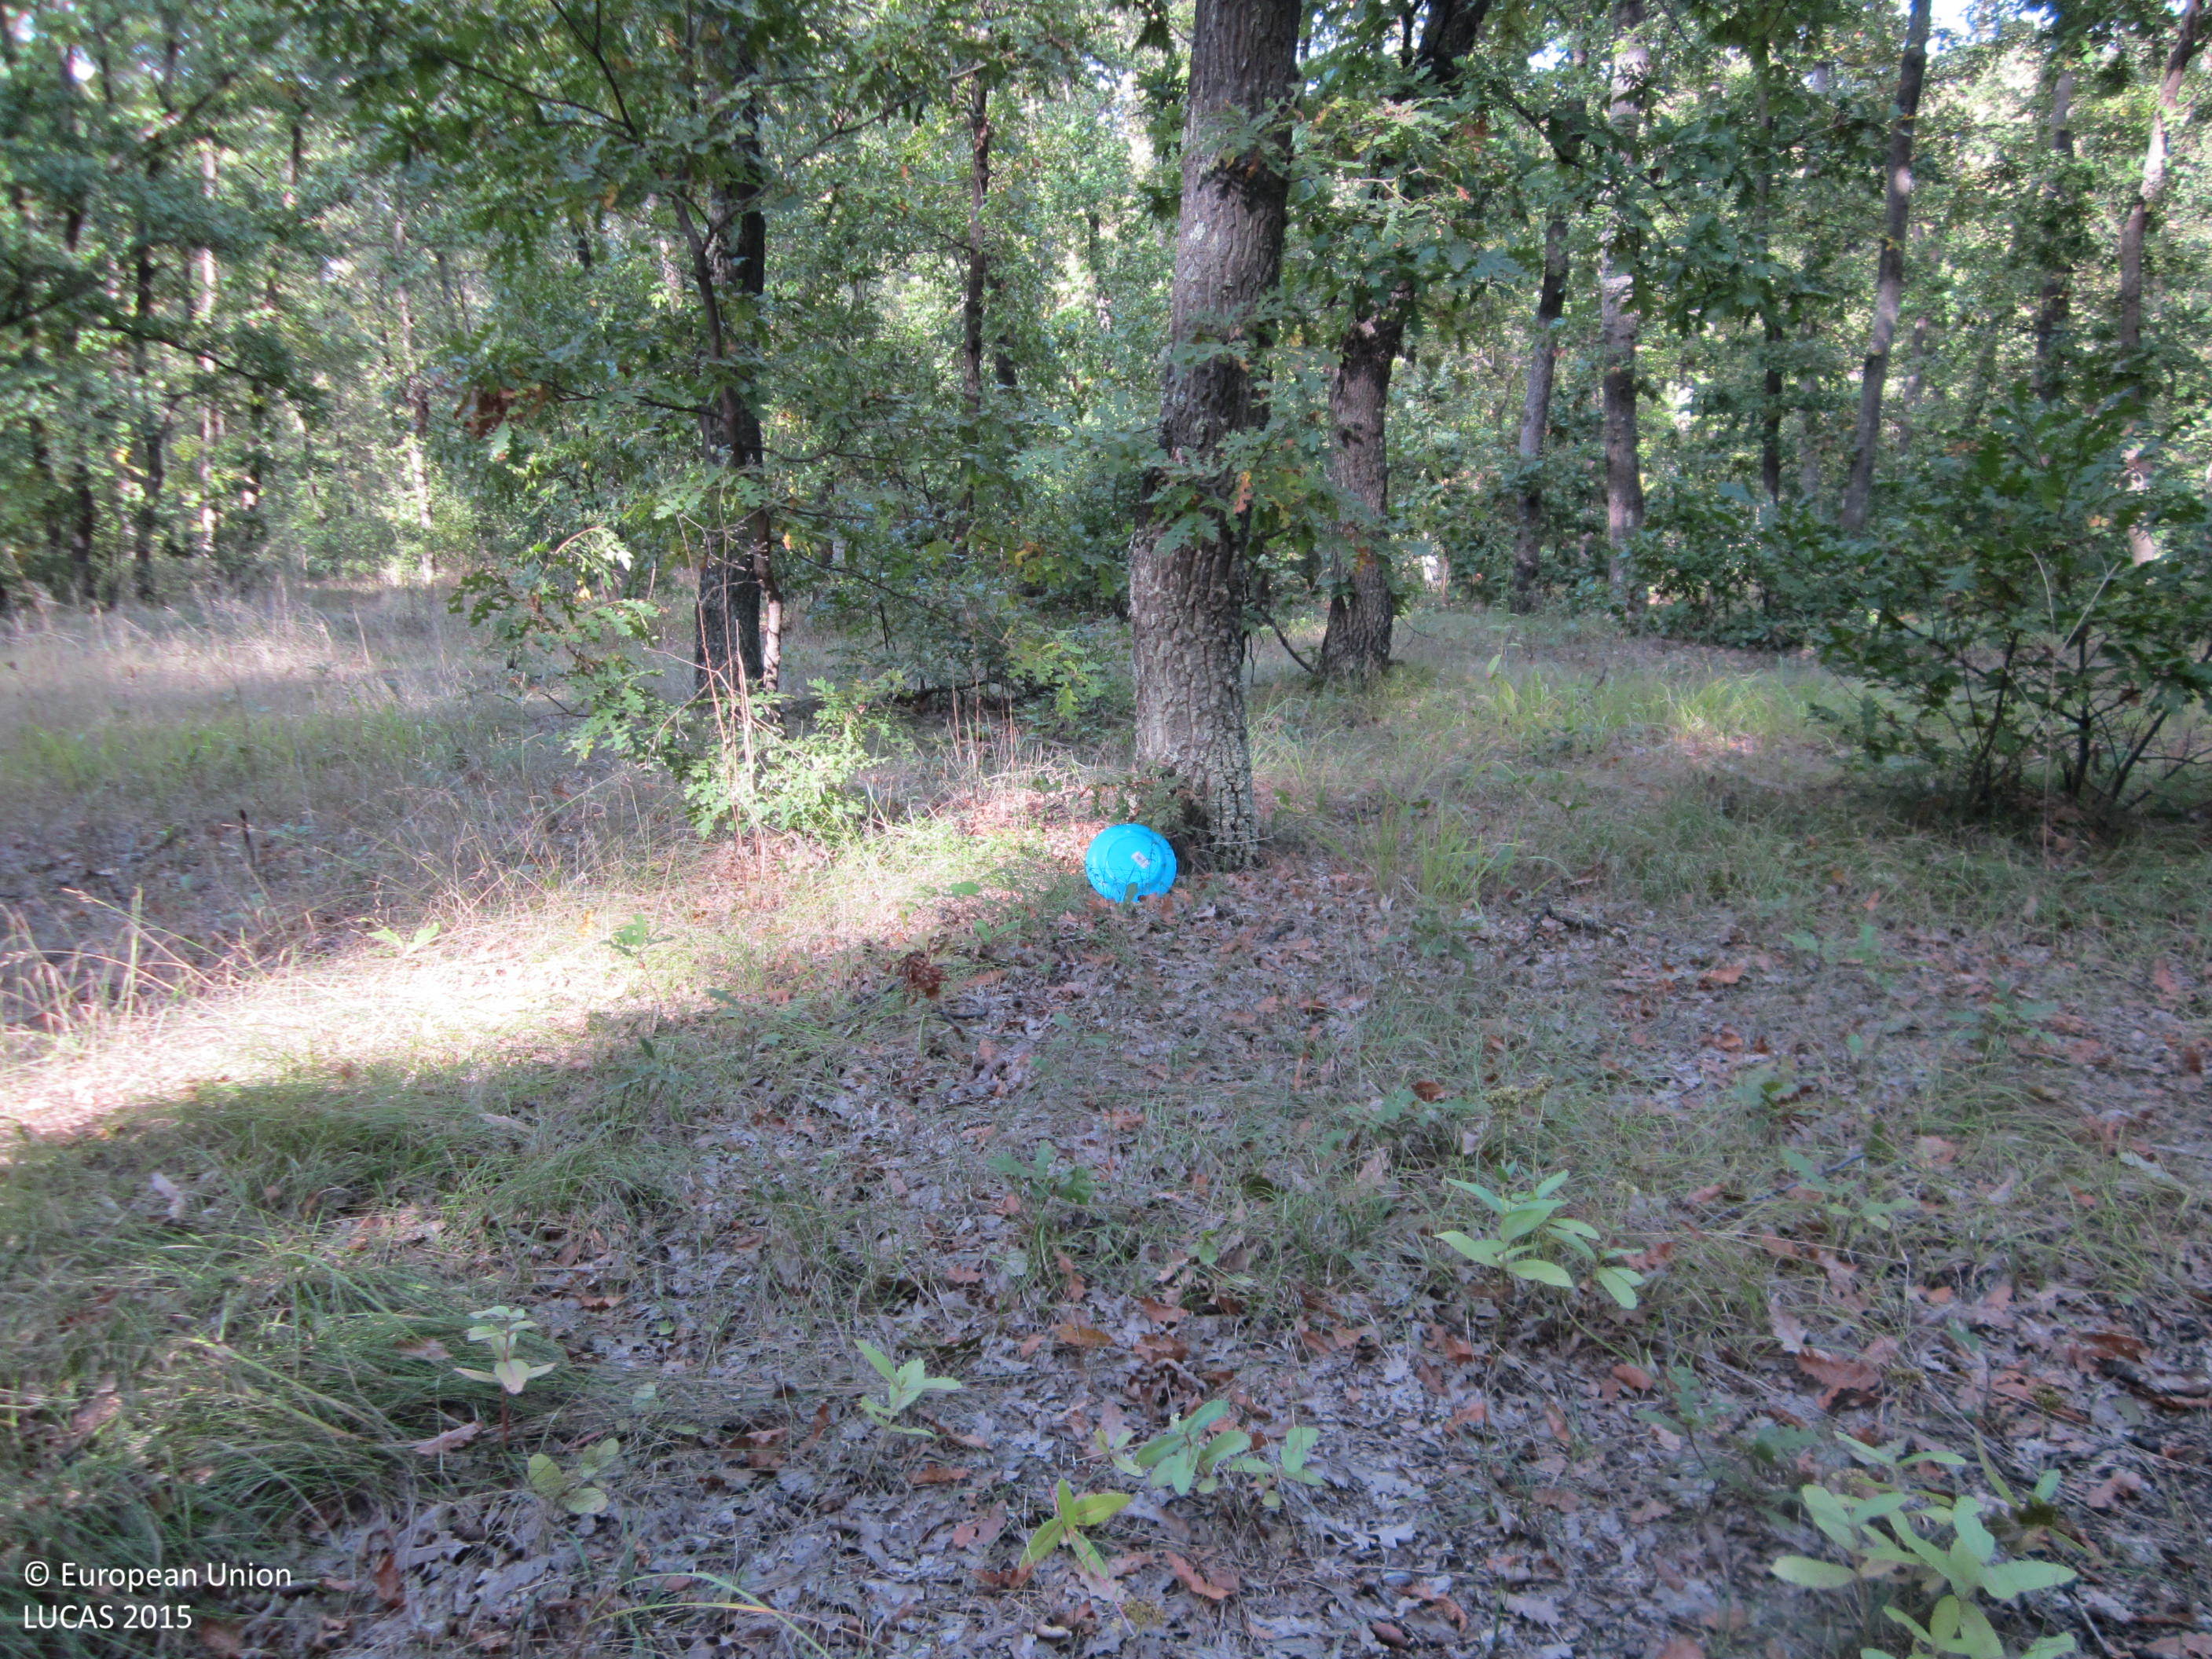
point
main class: Woodland
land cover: Broadleaved woodland
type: acidophilous oak and oak-birch forest
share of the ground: 50 - 75 %
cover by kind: broadleaved forest trees 65 %, herbaceous plants 35 %
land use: Forestry
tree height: > 5 m
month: October
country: BG
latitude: 42.8097
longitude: 26.8715
